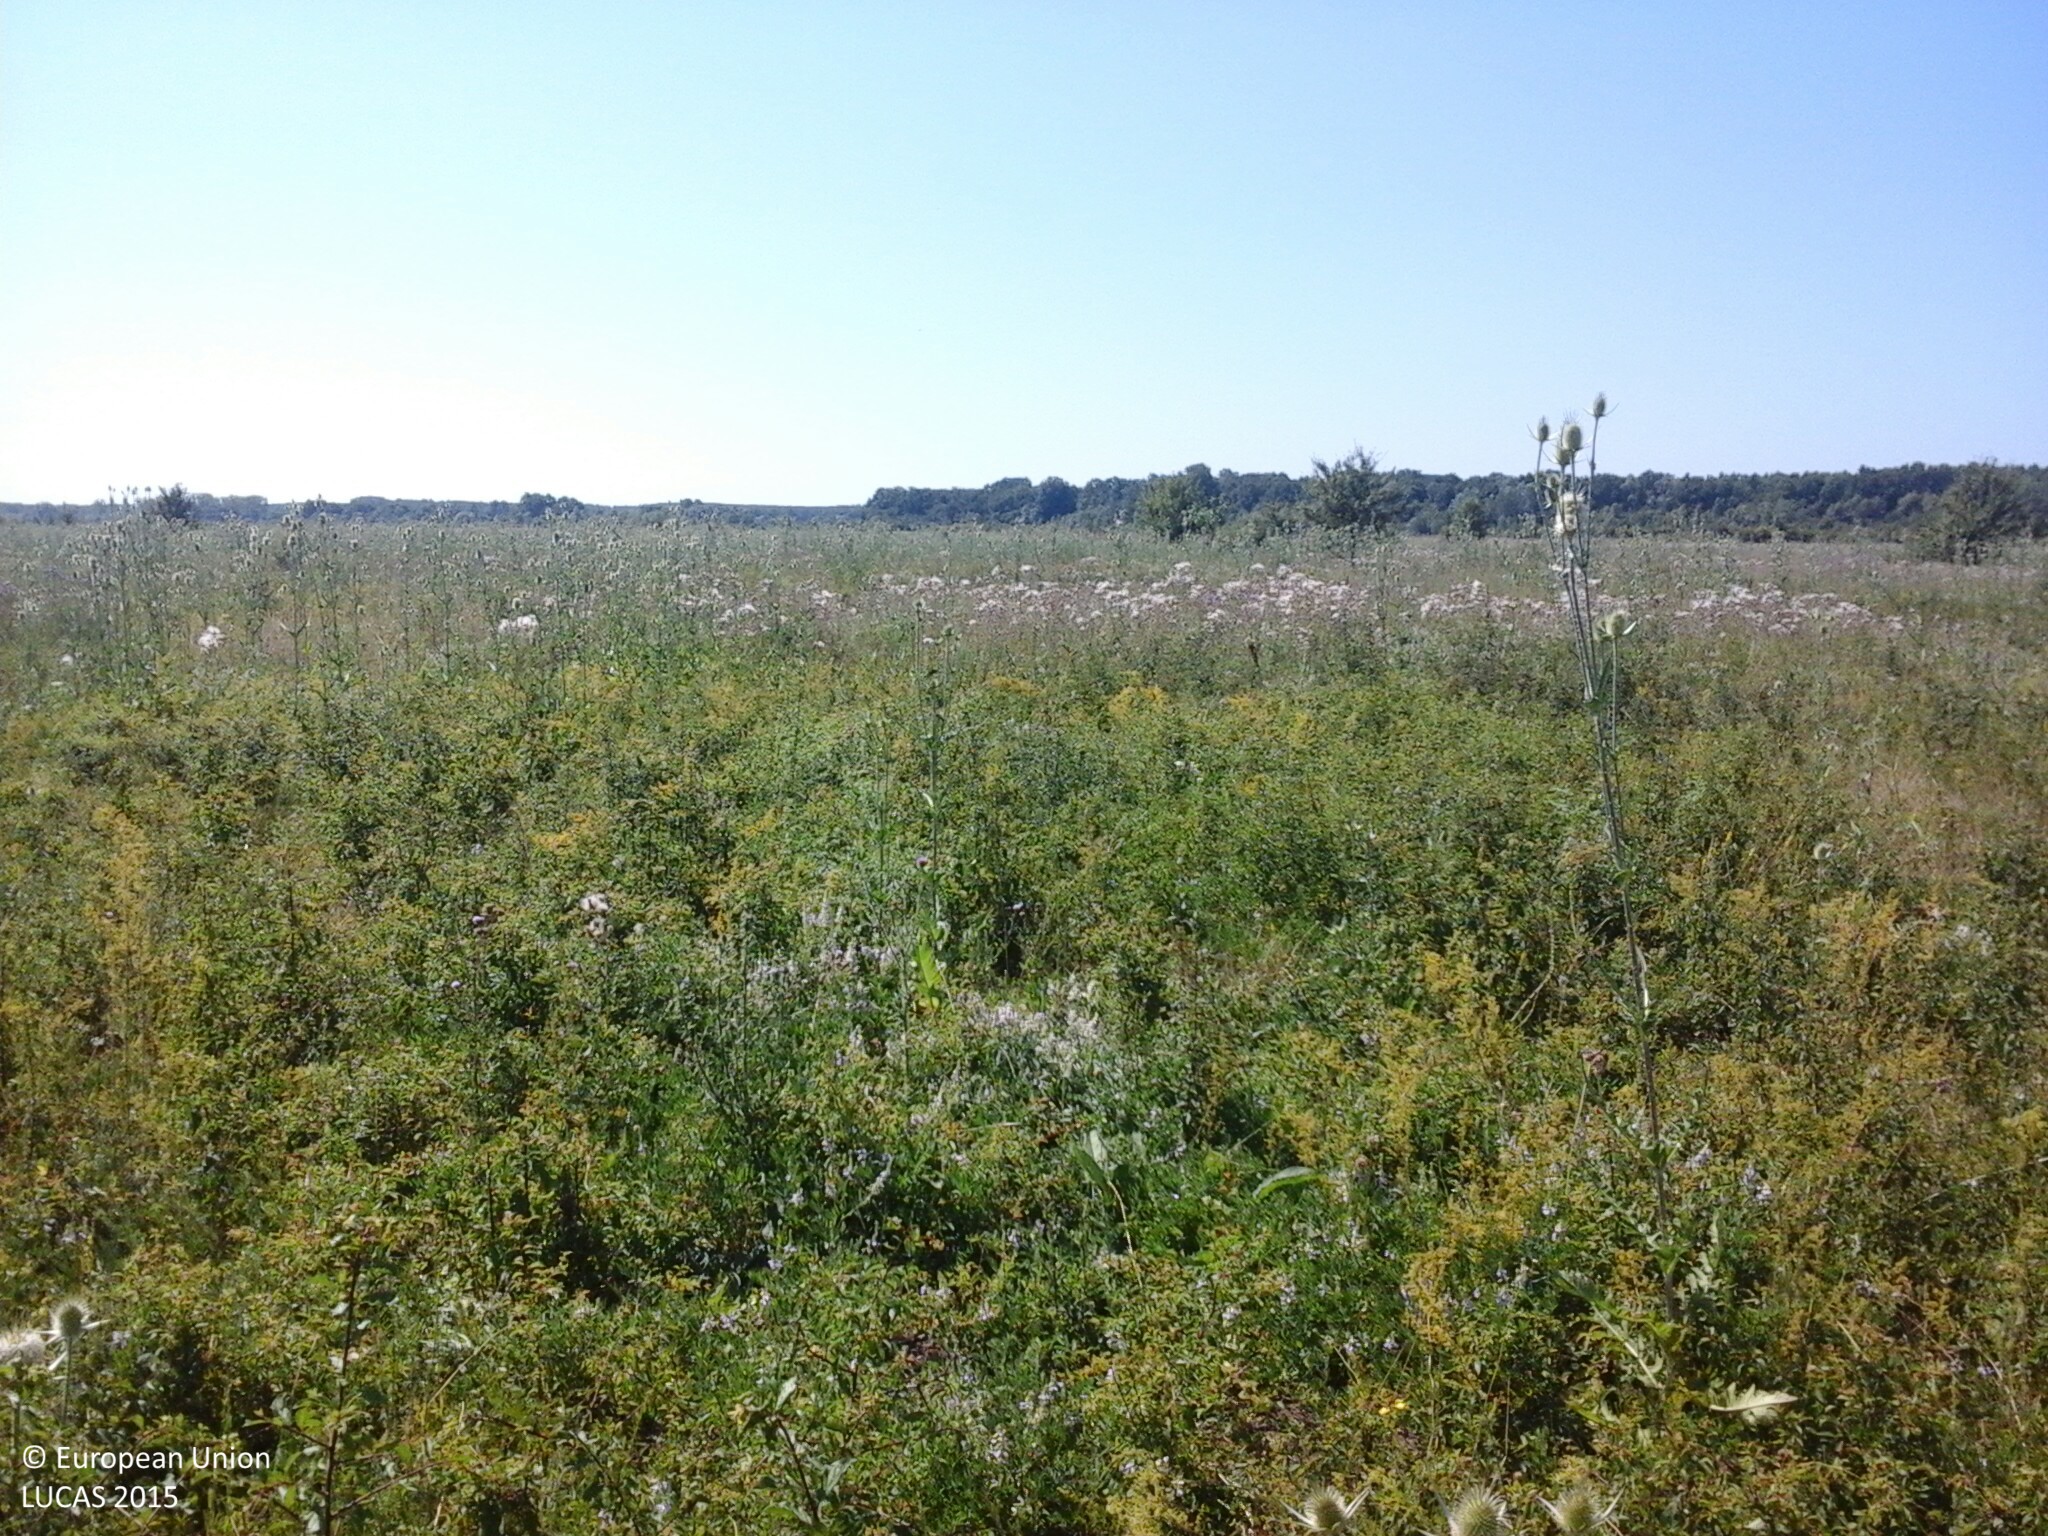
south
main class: Grassland
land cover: Spontaneously vegetated surfaces
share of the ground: > 75 %
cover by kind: herbaceous plants 100 %
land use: Semi-natural and natural areas not in use
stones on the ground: < 10 %
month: July
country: HU
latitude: 48.1205
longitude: 22.4043
